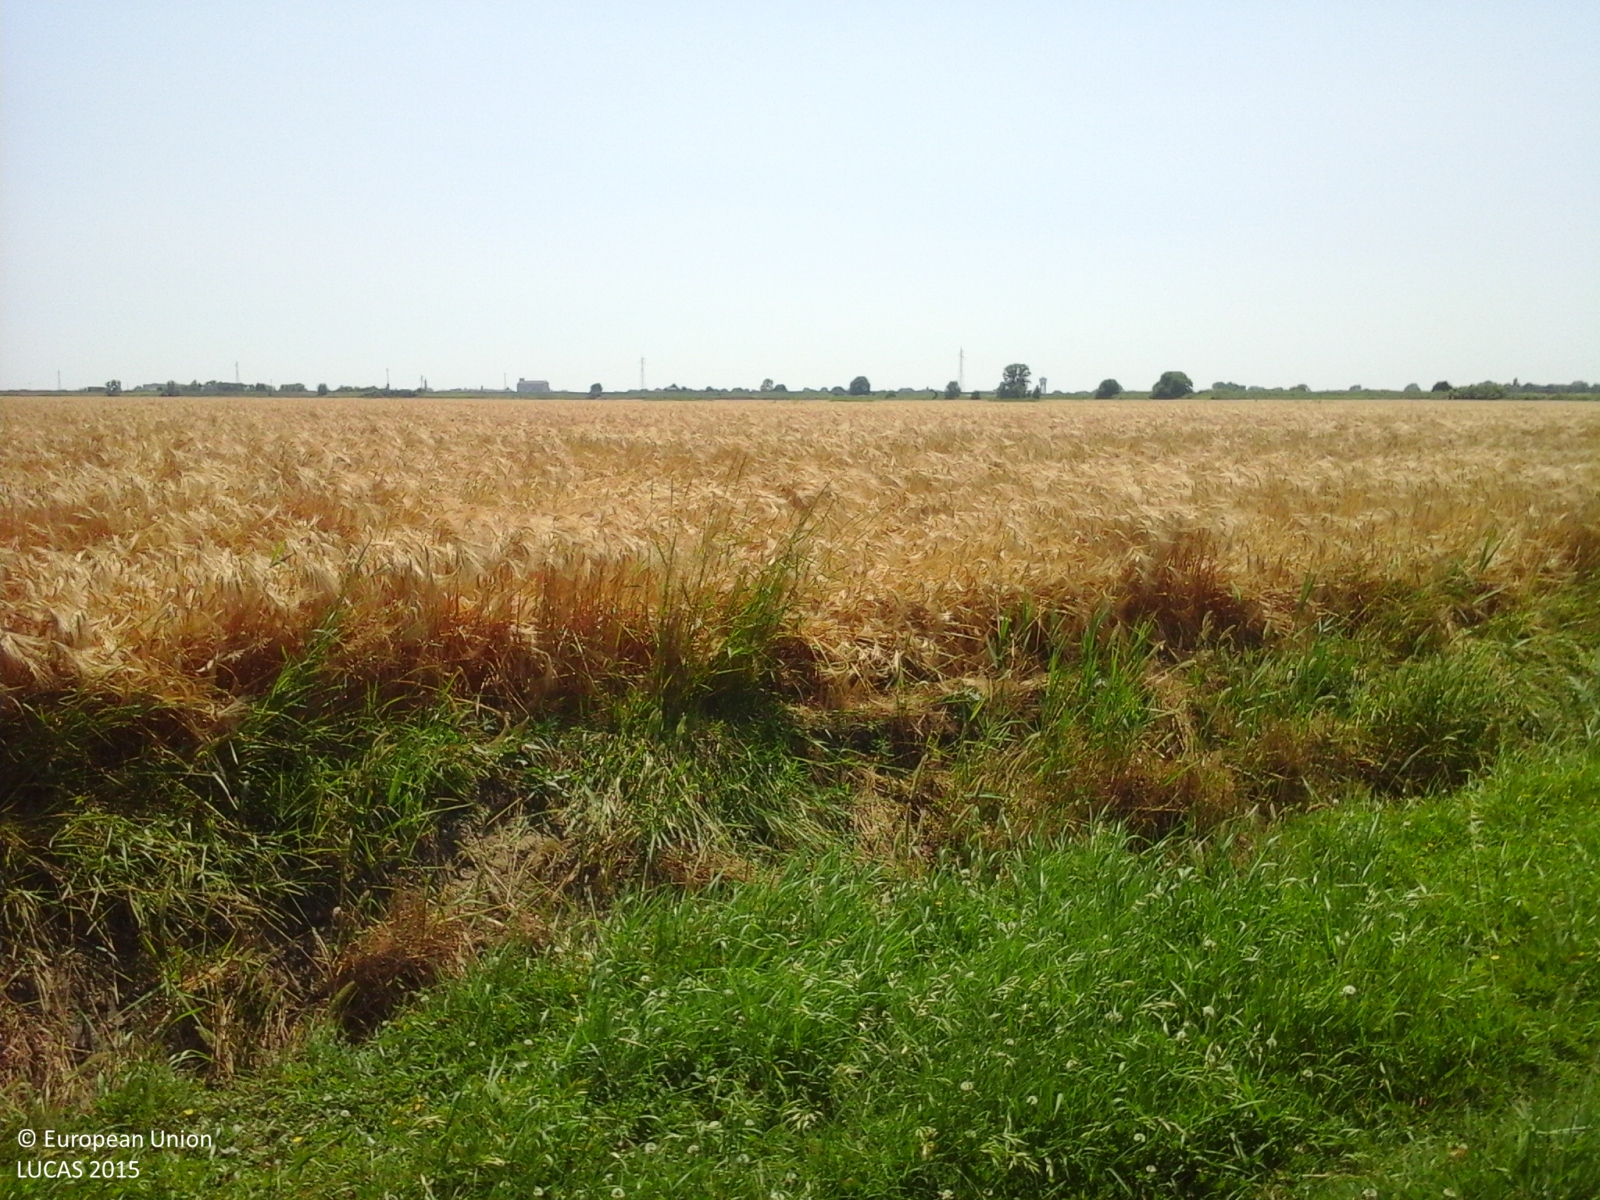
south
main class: Cropland
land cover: Common wheat
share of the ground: > 75 %
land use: Agriculture (excluding fallow land and kitchen gardens)
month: June
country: IT
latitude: 44.7246
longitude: 12.1799
